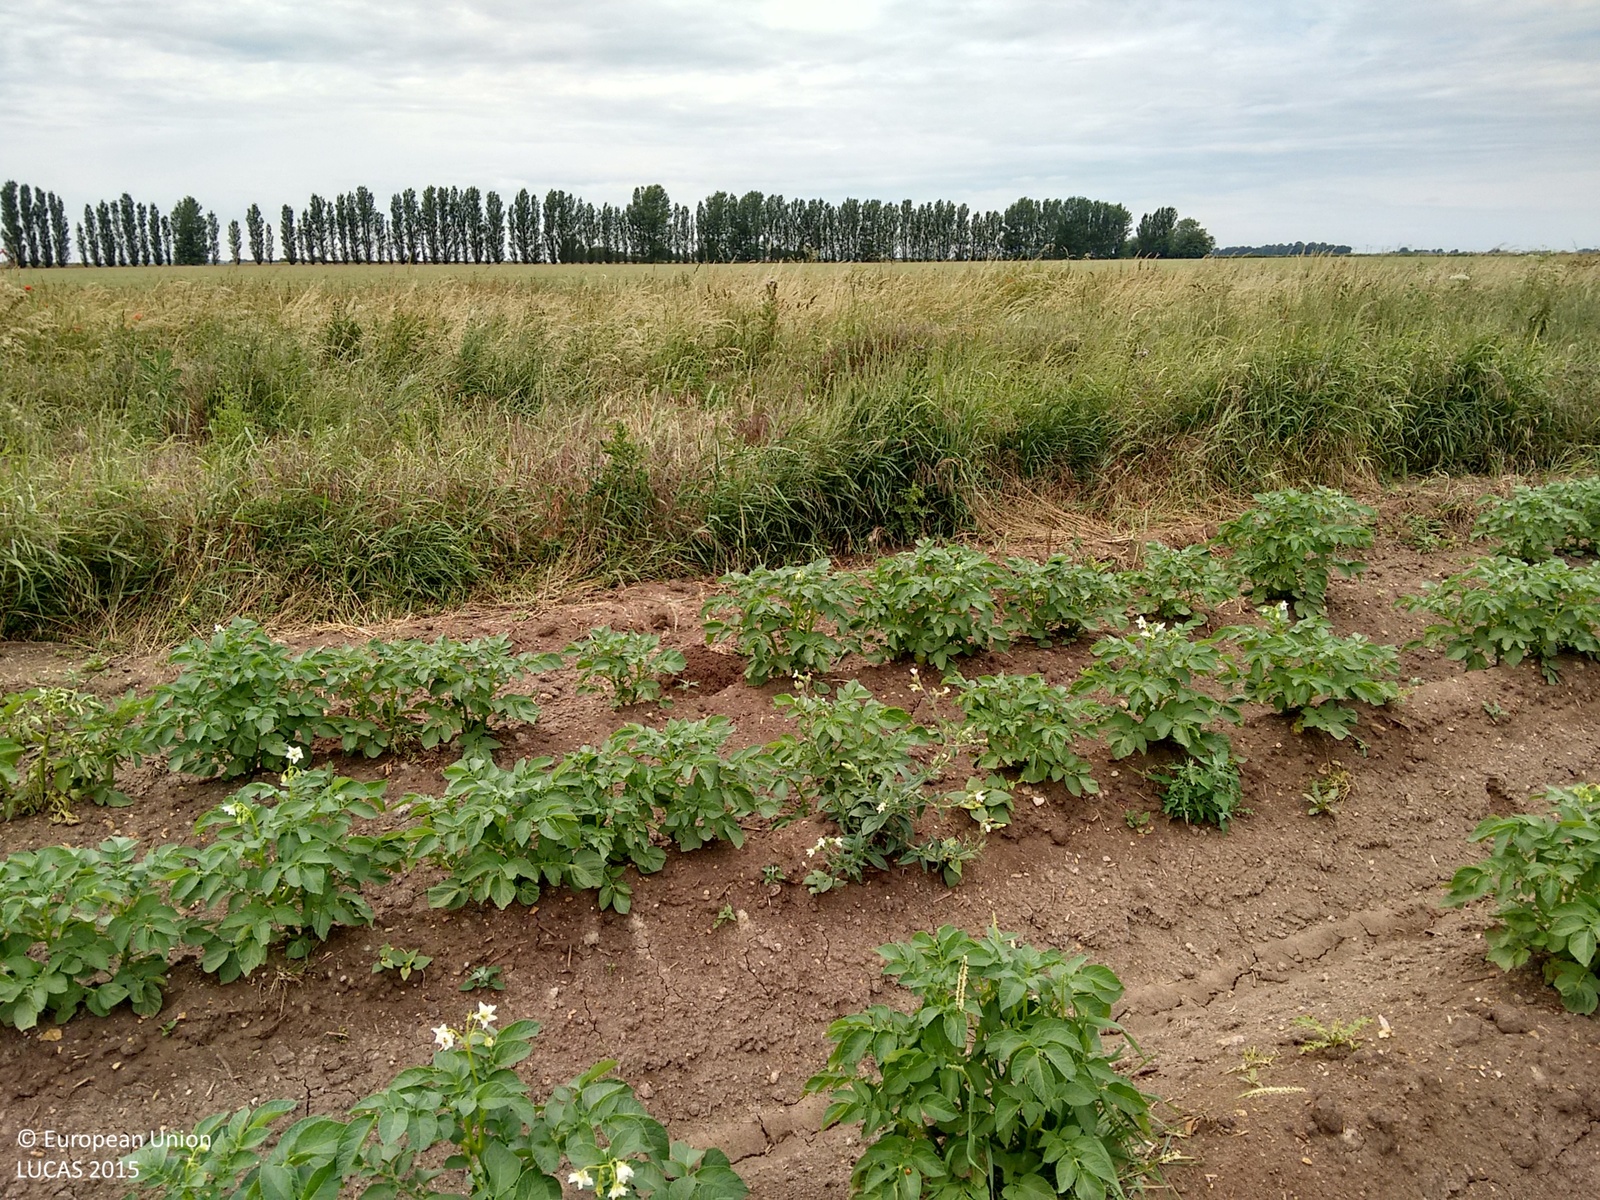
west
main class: Cropland
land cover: Potatoes
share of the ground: > 75 %
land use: Agriculture (excluding fallow land and kitchen gardens)
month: July
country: GB
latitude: 52.4643
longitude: 0.0326
